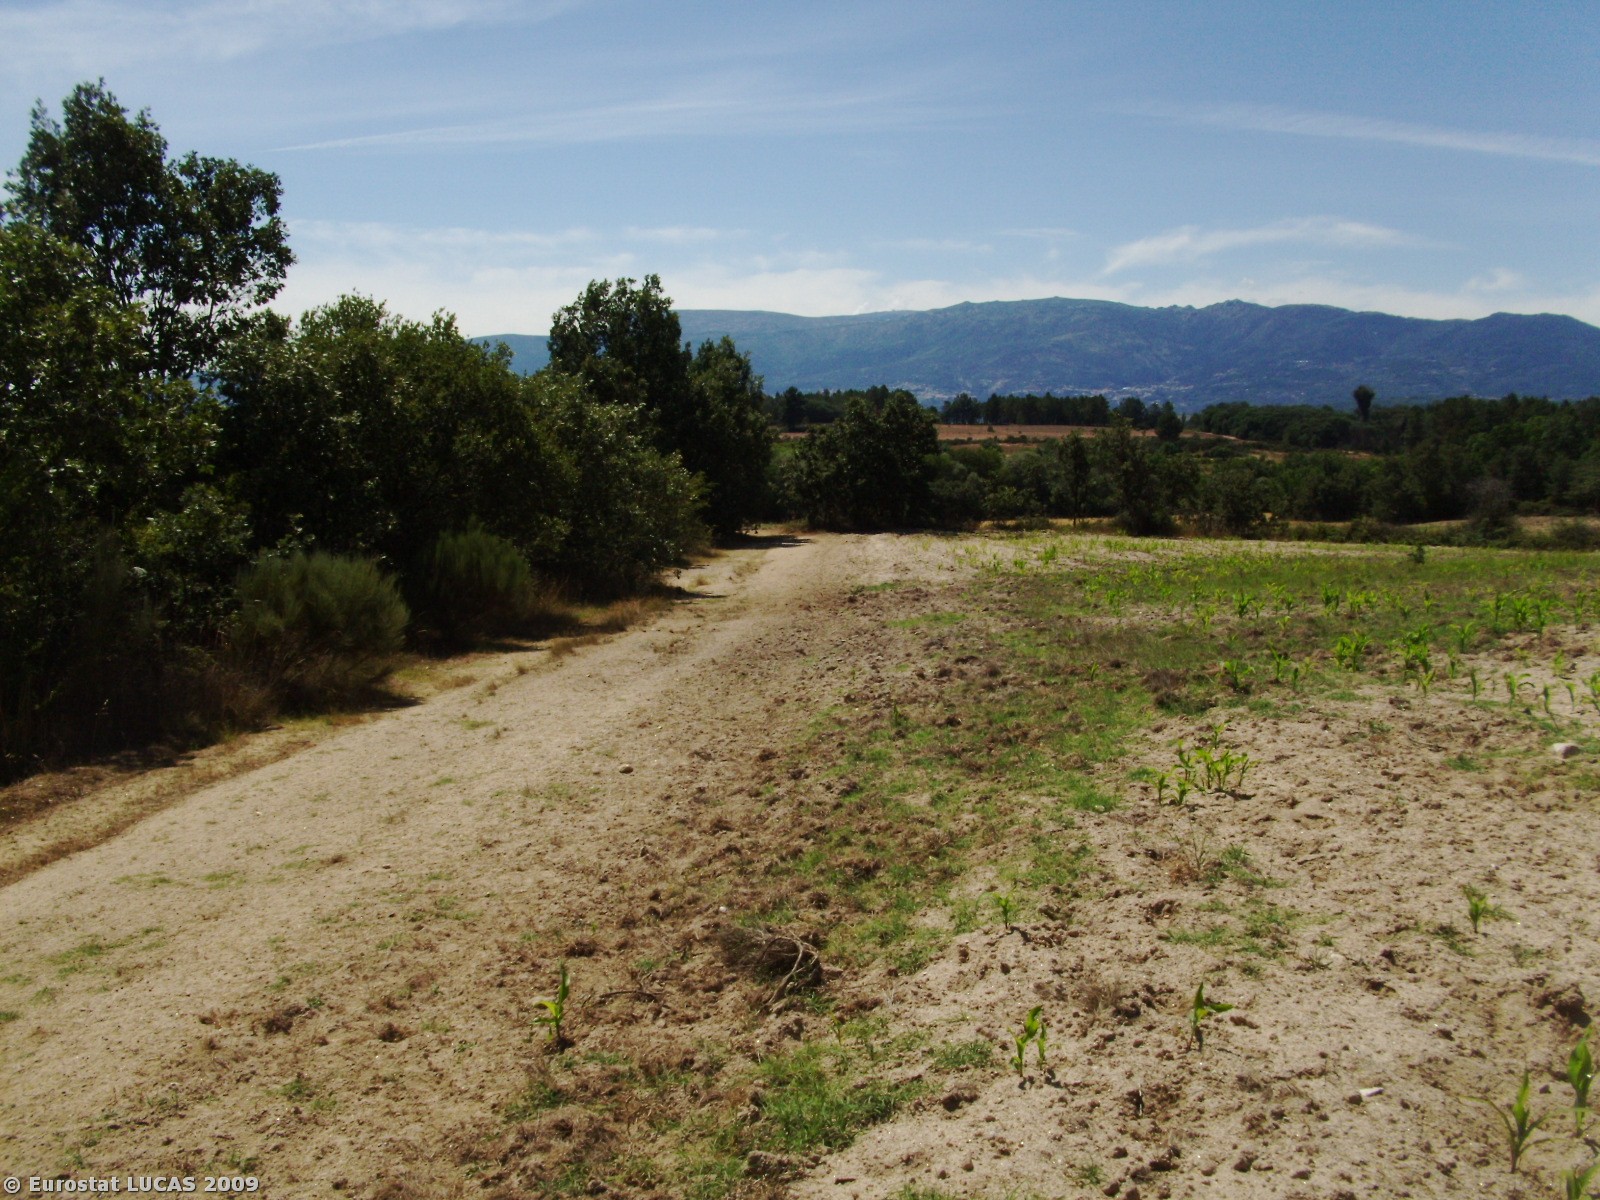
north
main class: Cropland
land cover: Maize
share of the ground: < 10 %
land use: Agriculture (excluding fallow land and kitchen gardens)
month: July
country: PT
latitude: 40.2712
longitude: -7.3794
